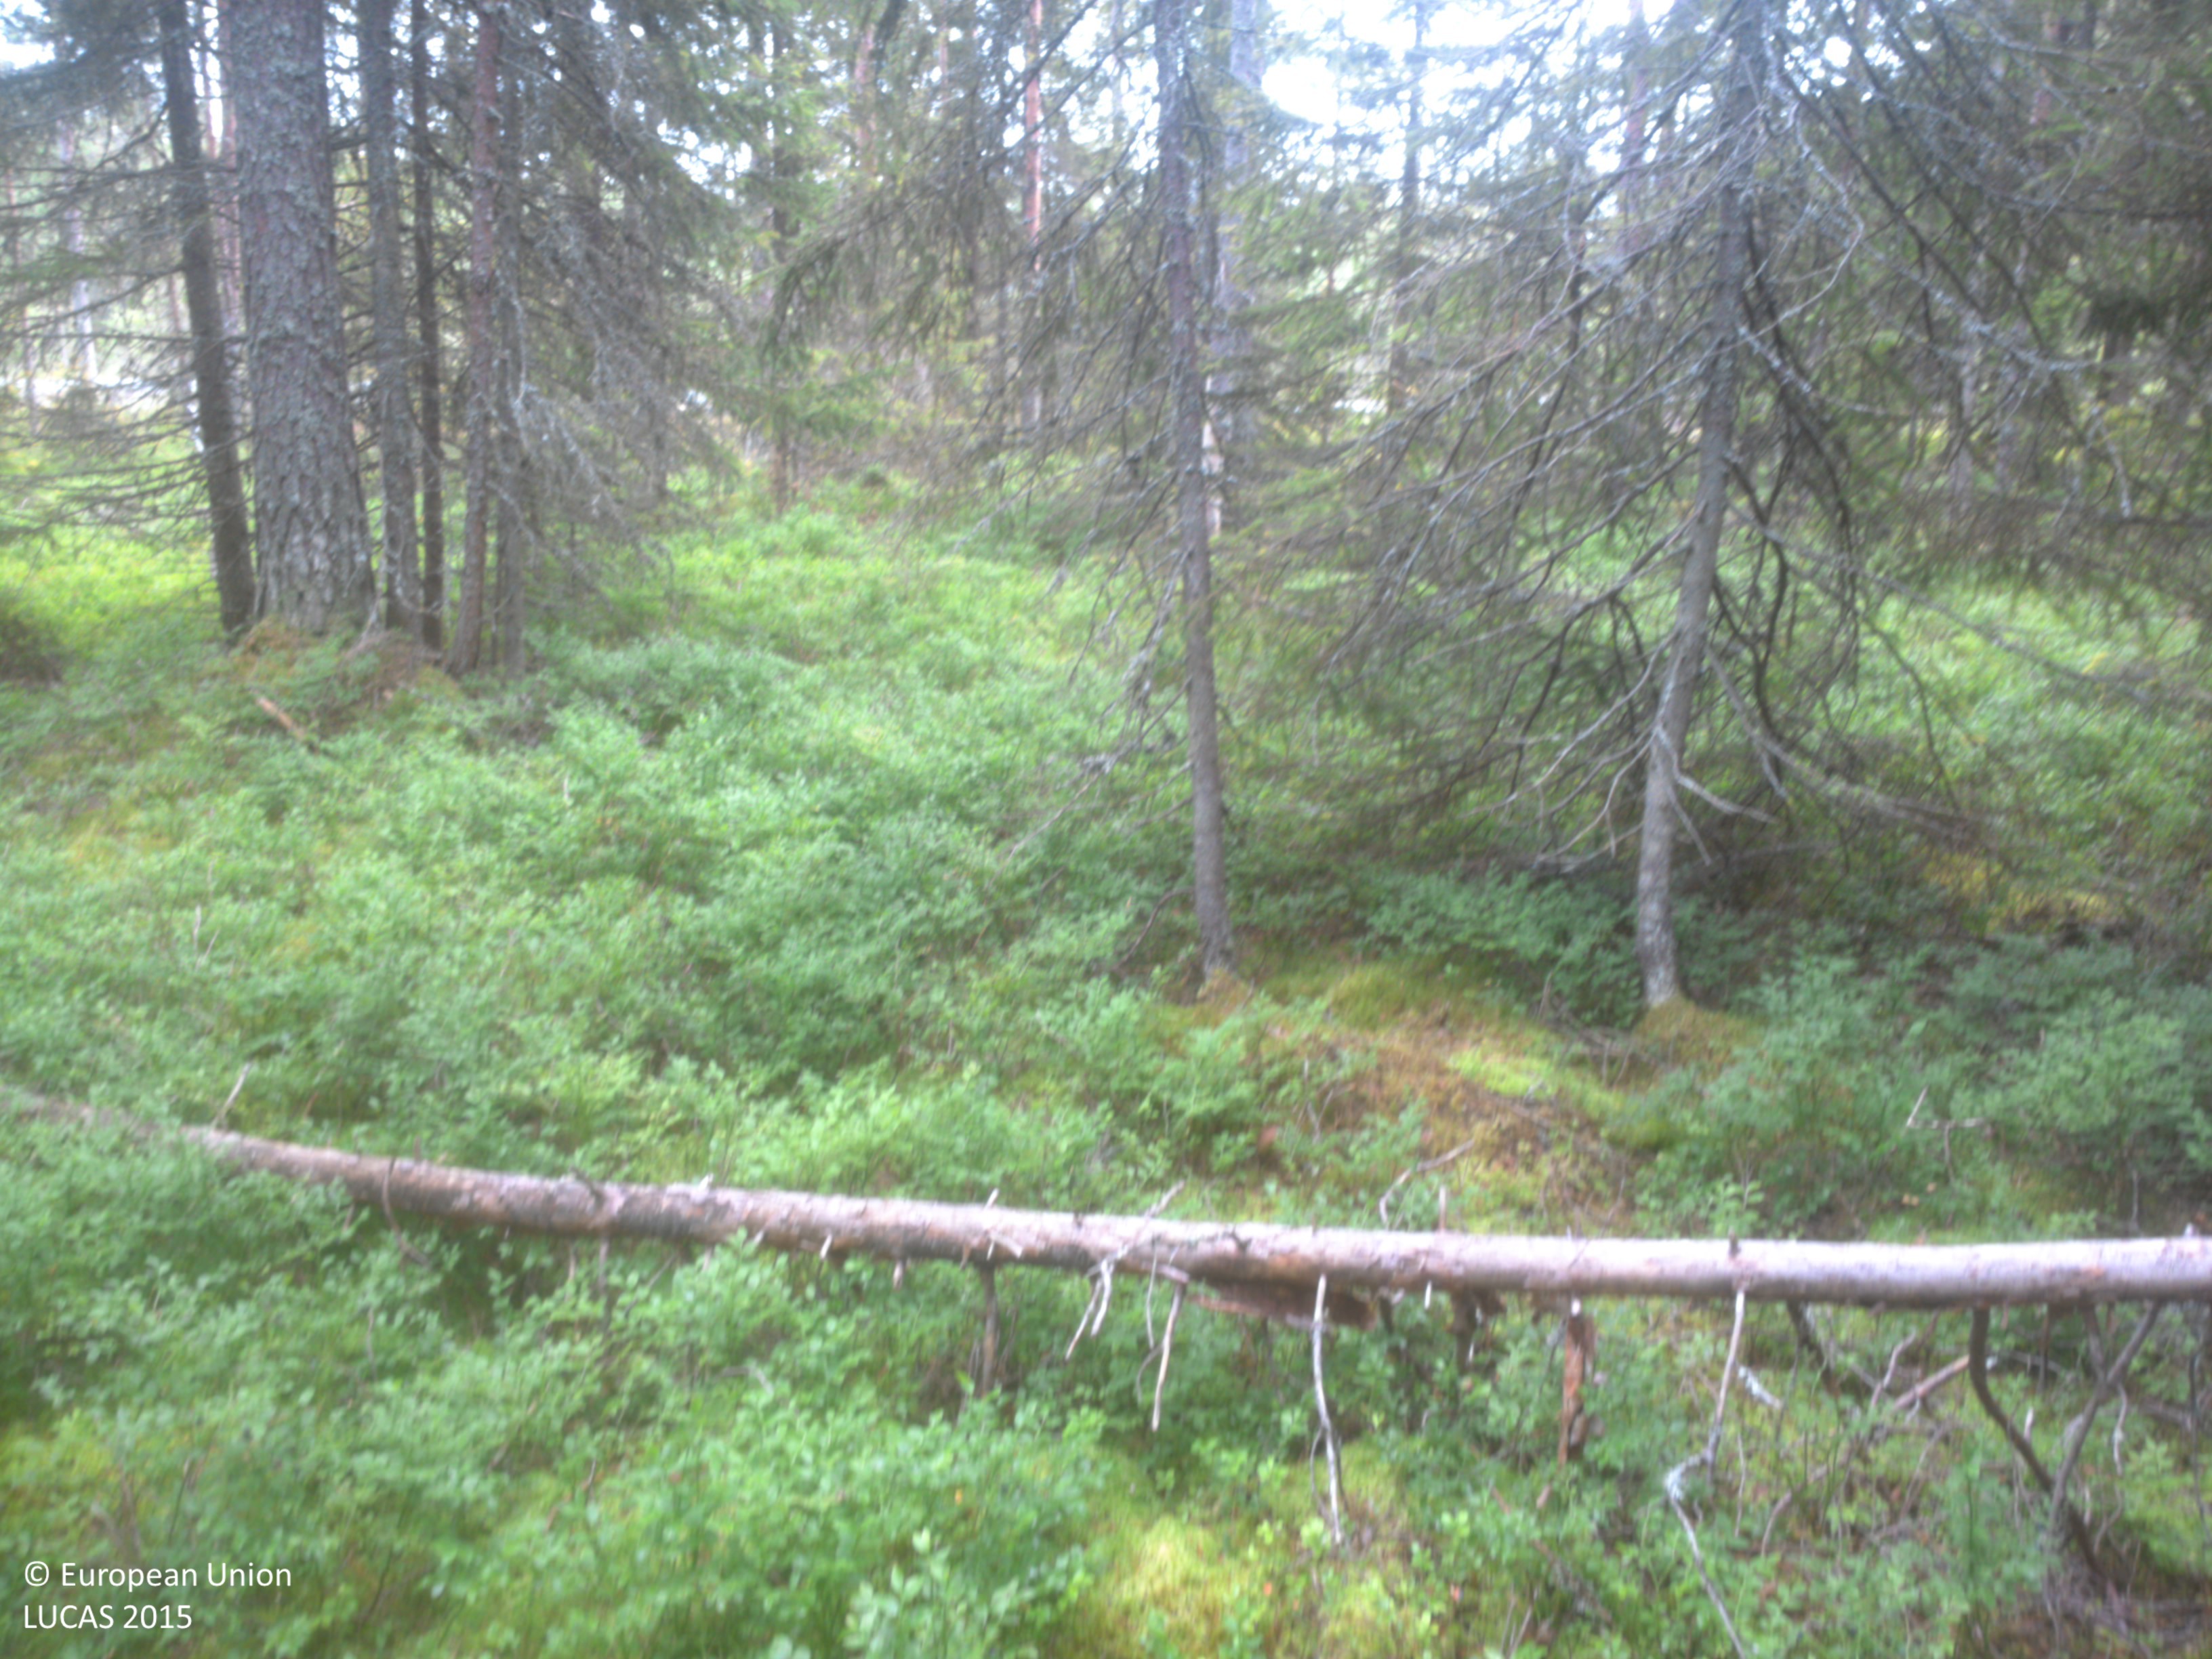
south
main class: Woodland
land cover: Other coniferous woodland
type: boreal forest
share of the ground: 50 - 75 %
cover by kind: coniferous forest trees 70 %, shrubs 20 %, lichens and mosses 10 %
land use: Forestry
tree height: > 5 m
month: August
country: SE
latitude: 63.7428
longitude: 19.8873
